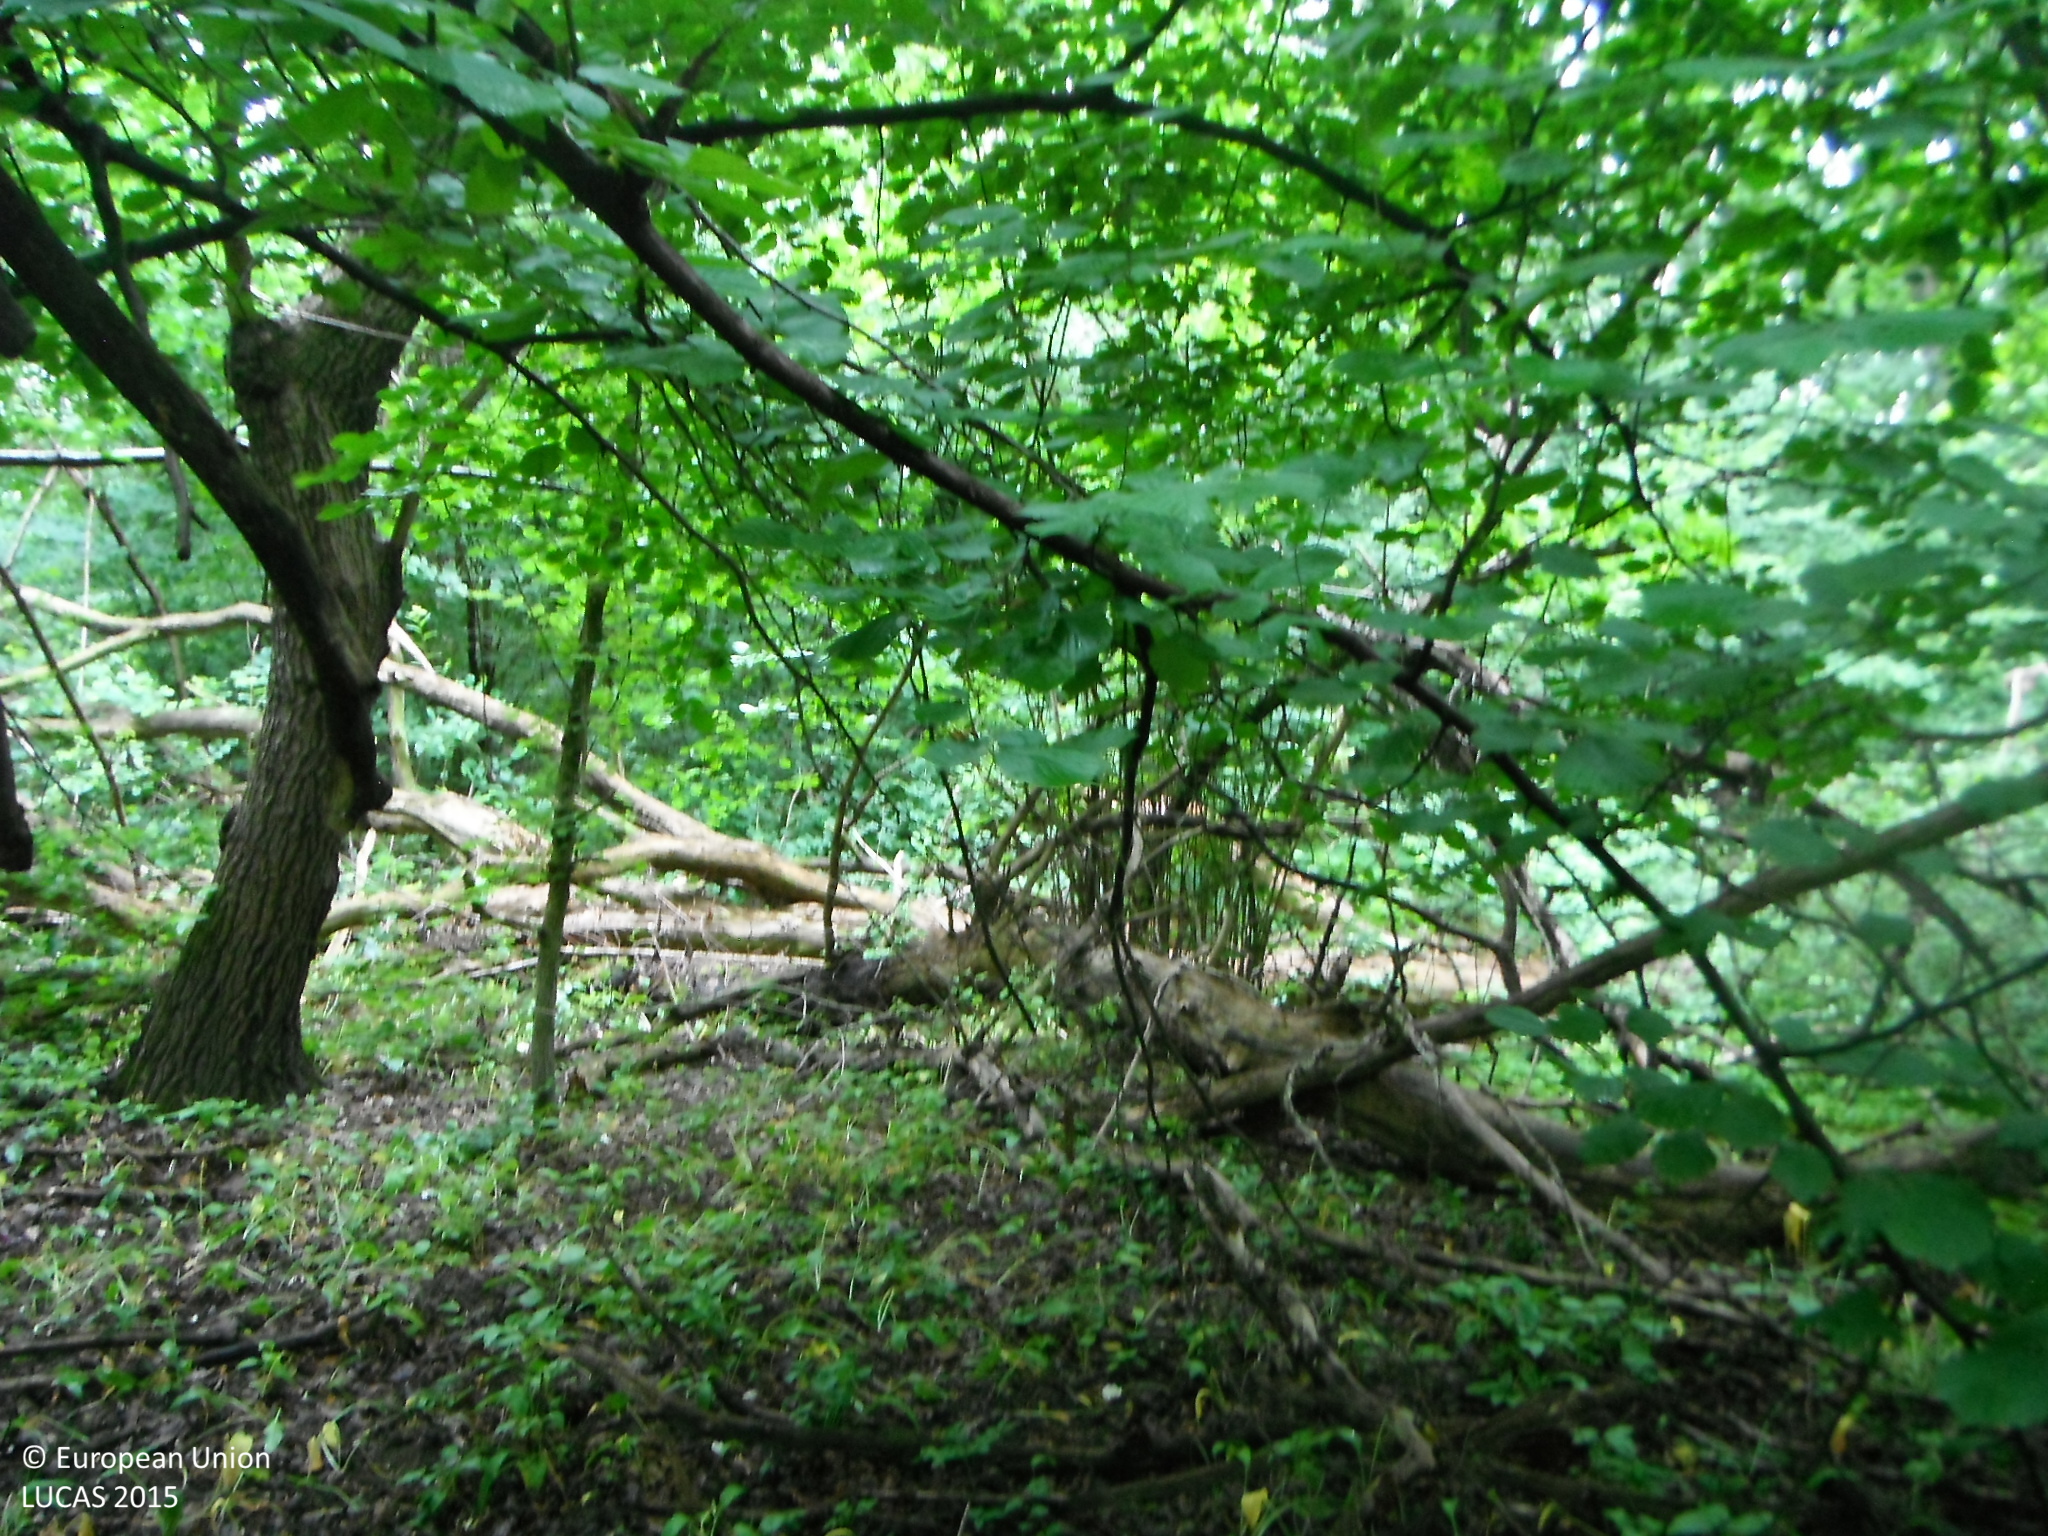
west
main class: Woodland
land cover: Broadleaved woodland
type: floodplain forest
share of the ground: > 75 %
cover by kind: broadleaved forest trees 90 %, herbaceous plants 10 %
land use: Forestry
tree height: > 5 m
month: June
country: SK
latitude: 48.0808
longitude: 17.1627
